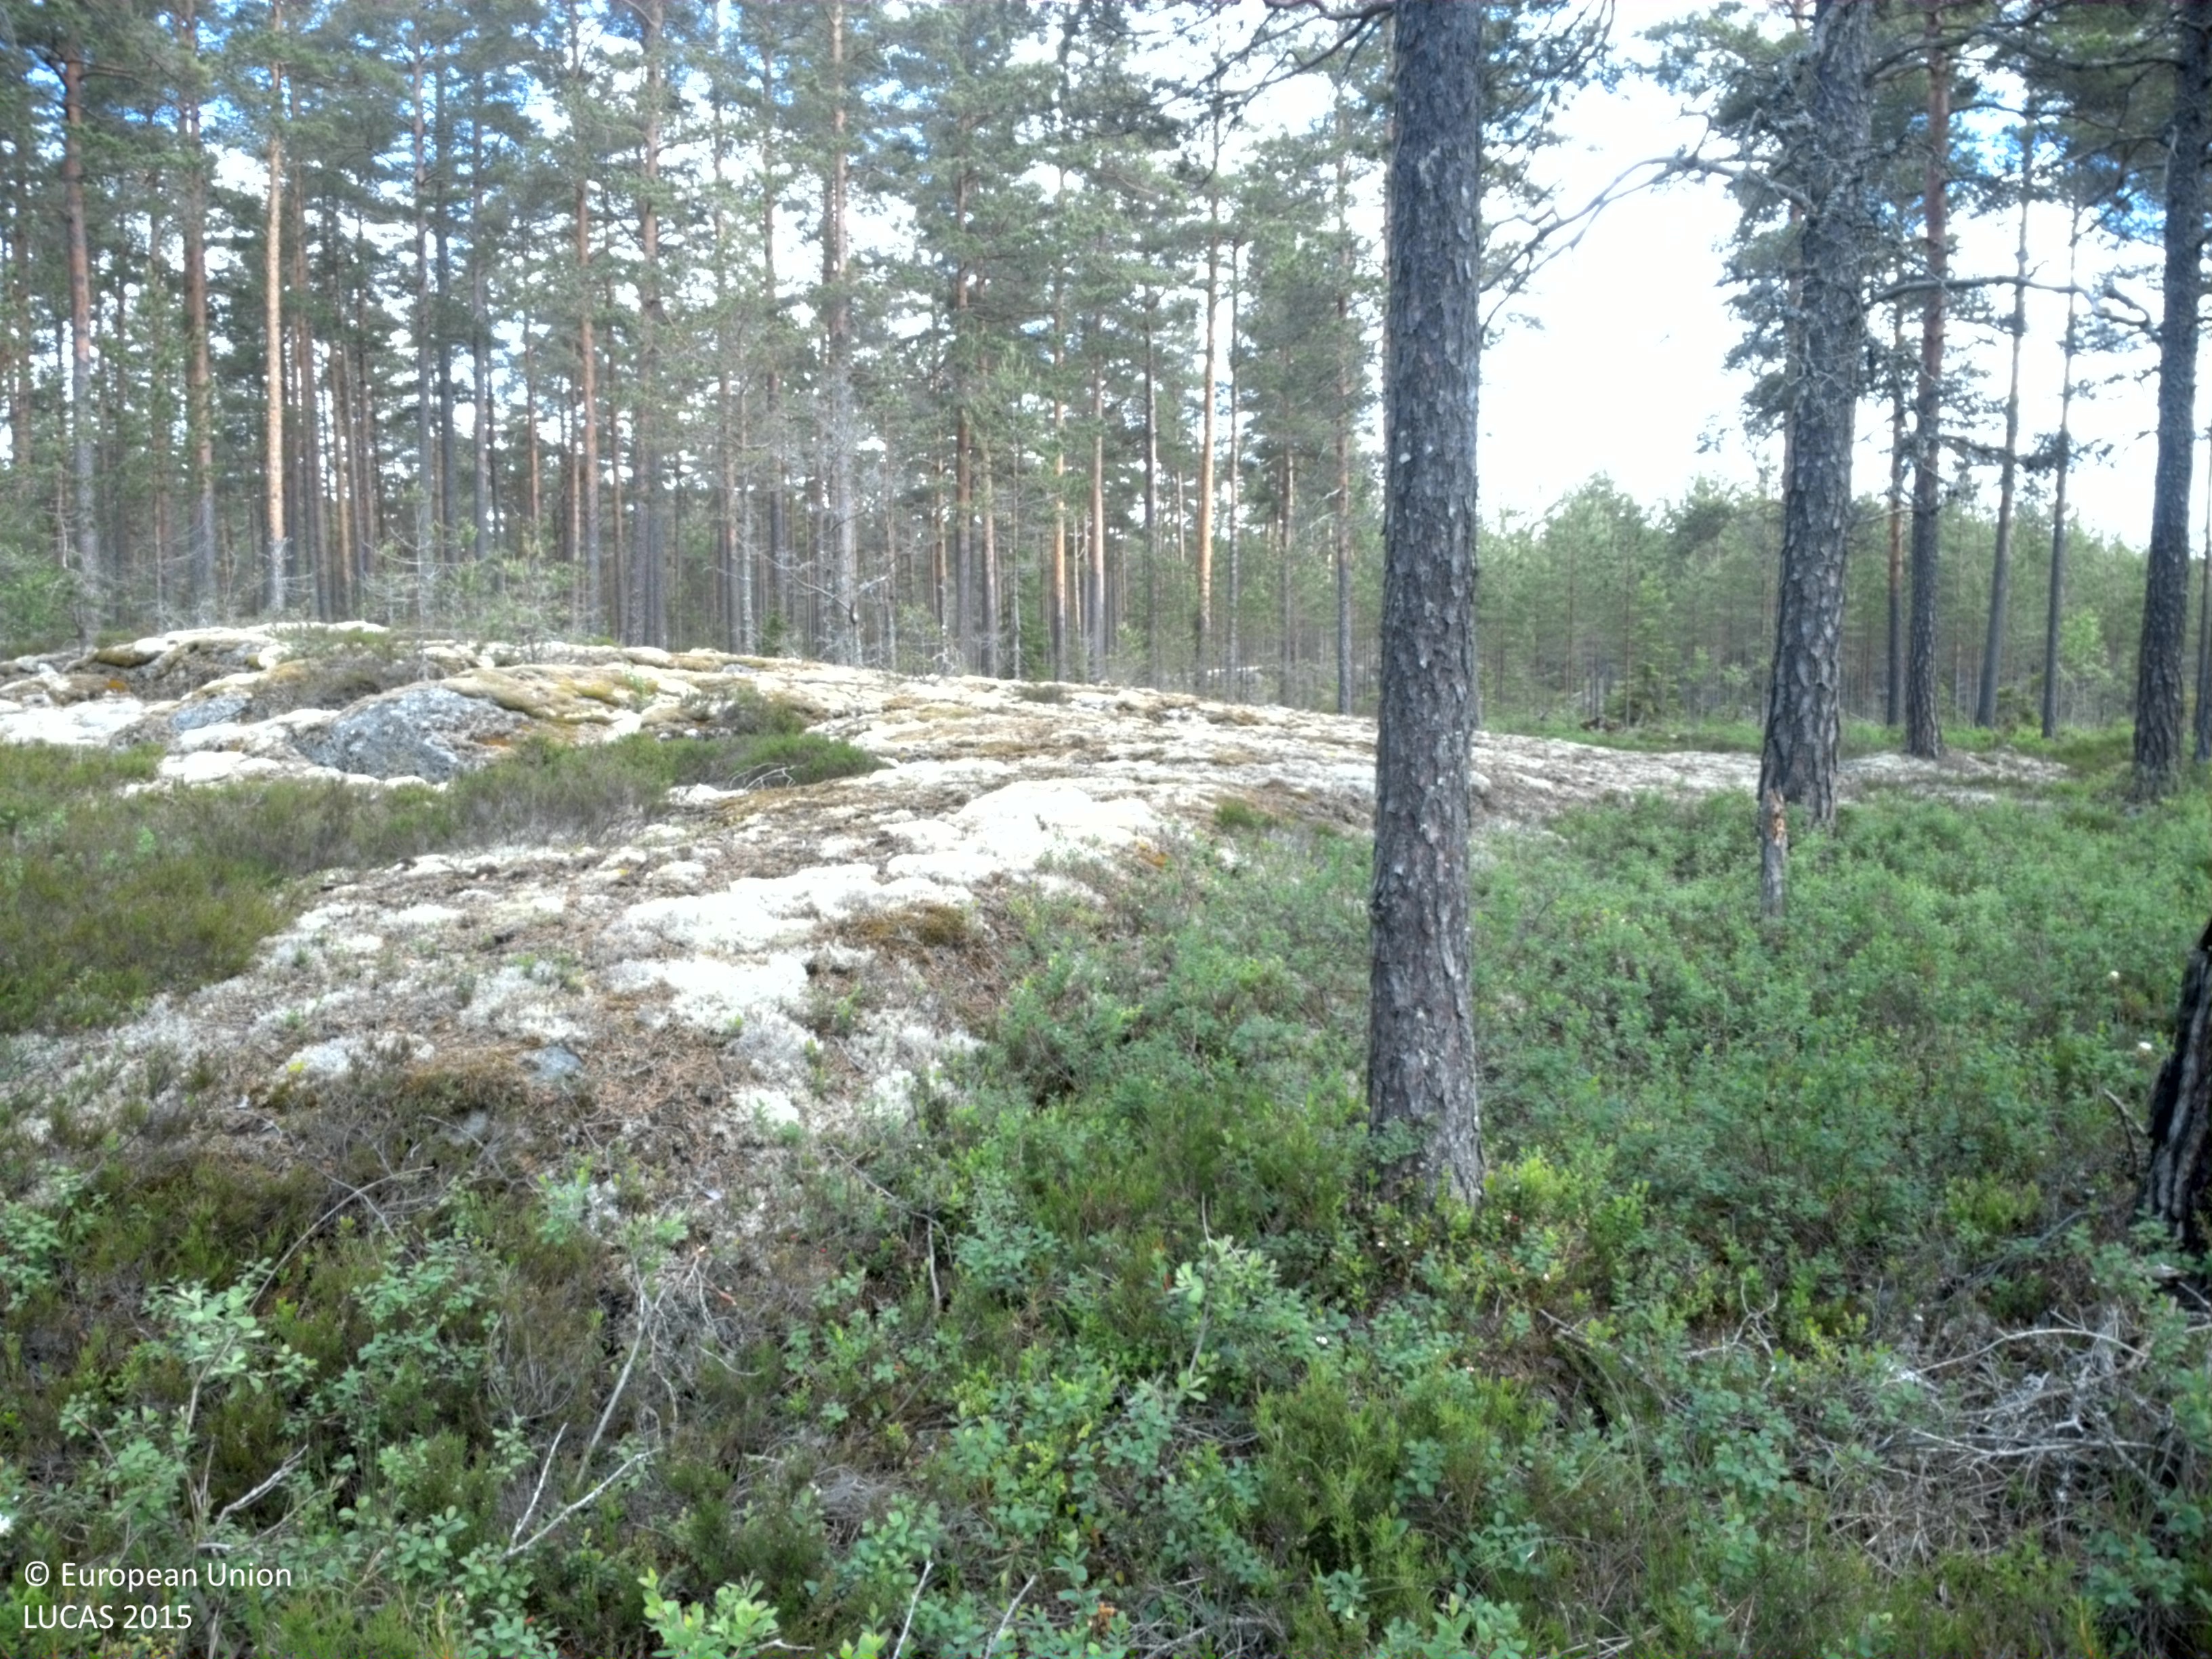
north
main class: Woodland
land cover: Pine dominated coniferous woodland
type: boreal forest
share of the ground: 25 - 50 %
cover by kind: lichens and mosses 50 %, coniferous forest trees 25 %, herbaceous plants 20 %, broadleaved forest trees 5 %
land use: Forestry
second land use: Amenities, museums, leisure
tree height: > 5 m
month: June
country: SE
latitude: 59.9297
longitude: 17.0955
